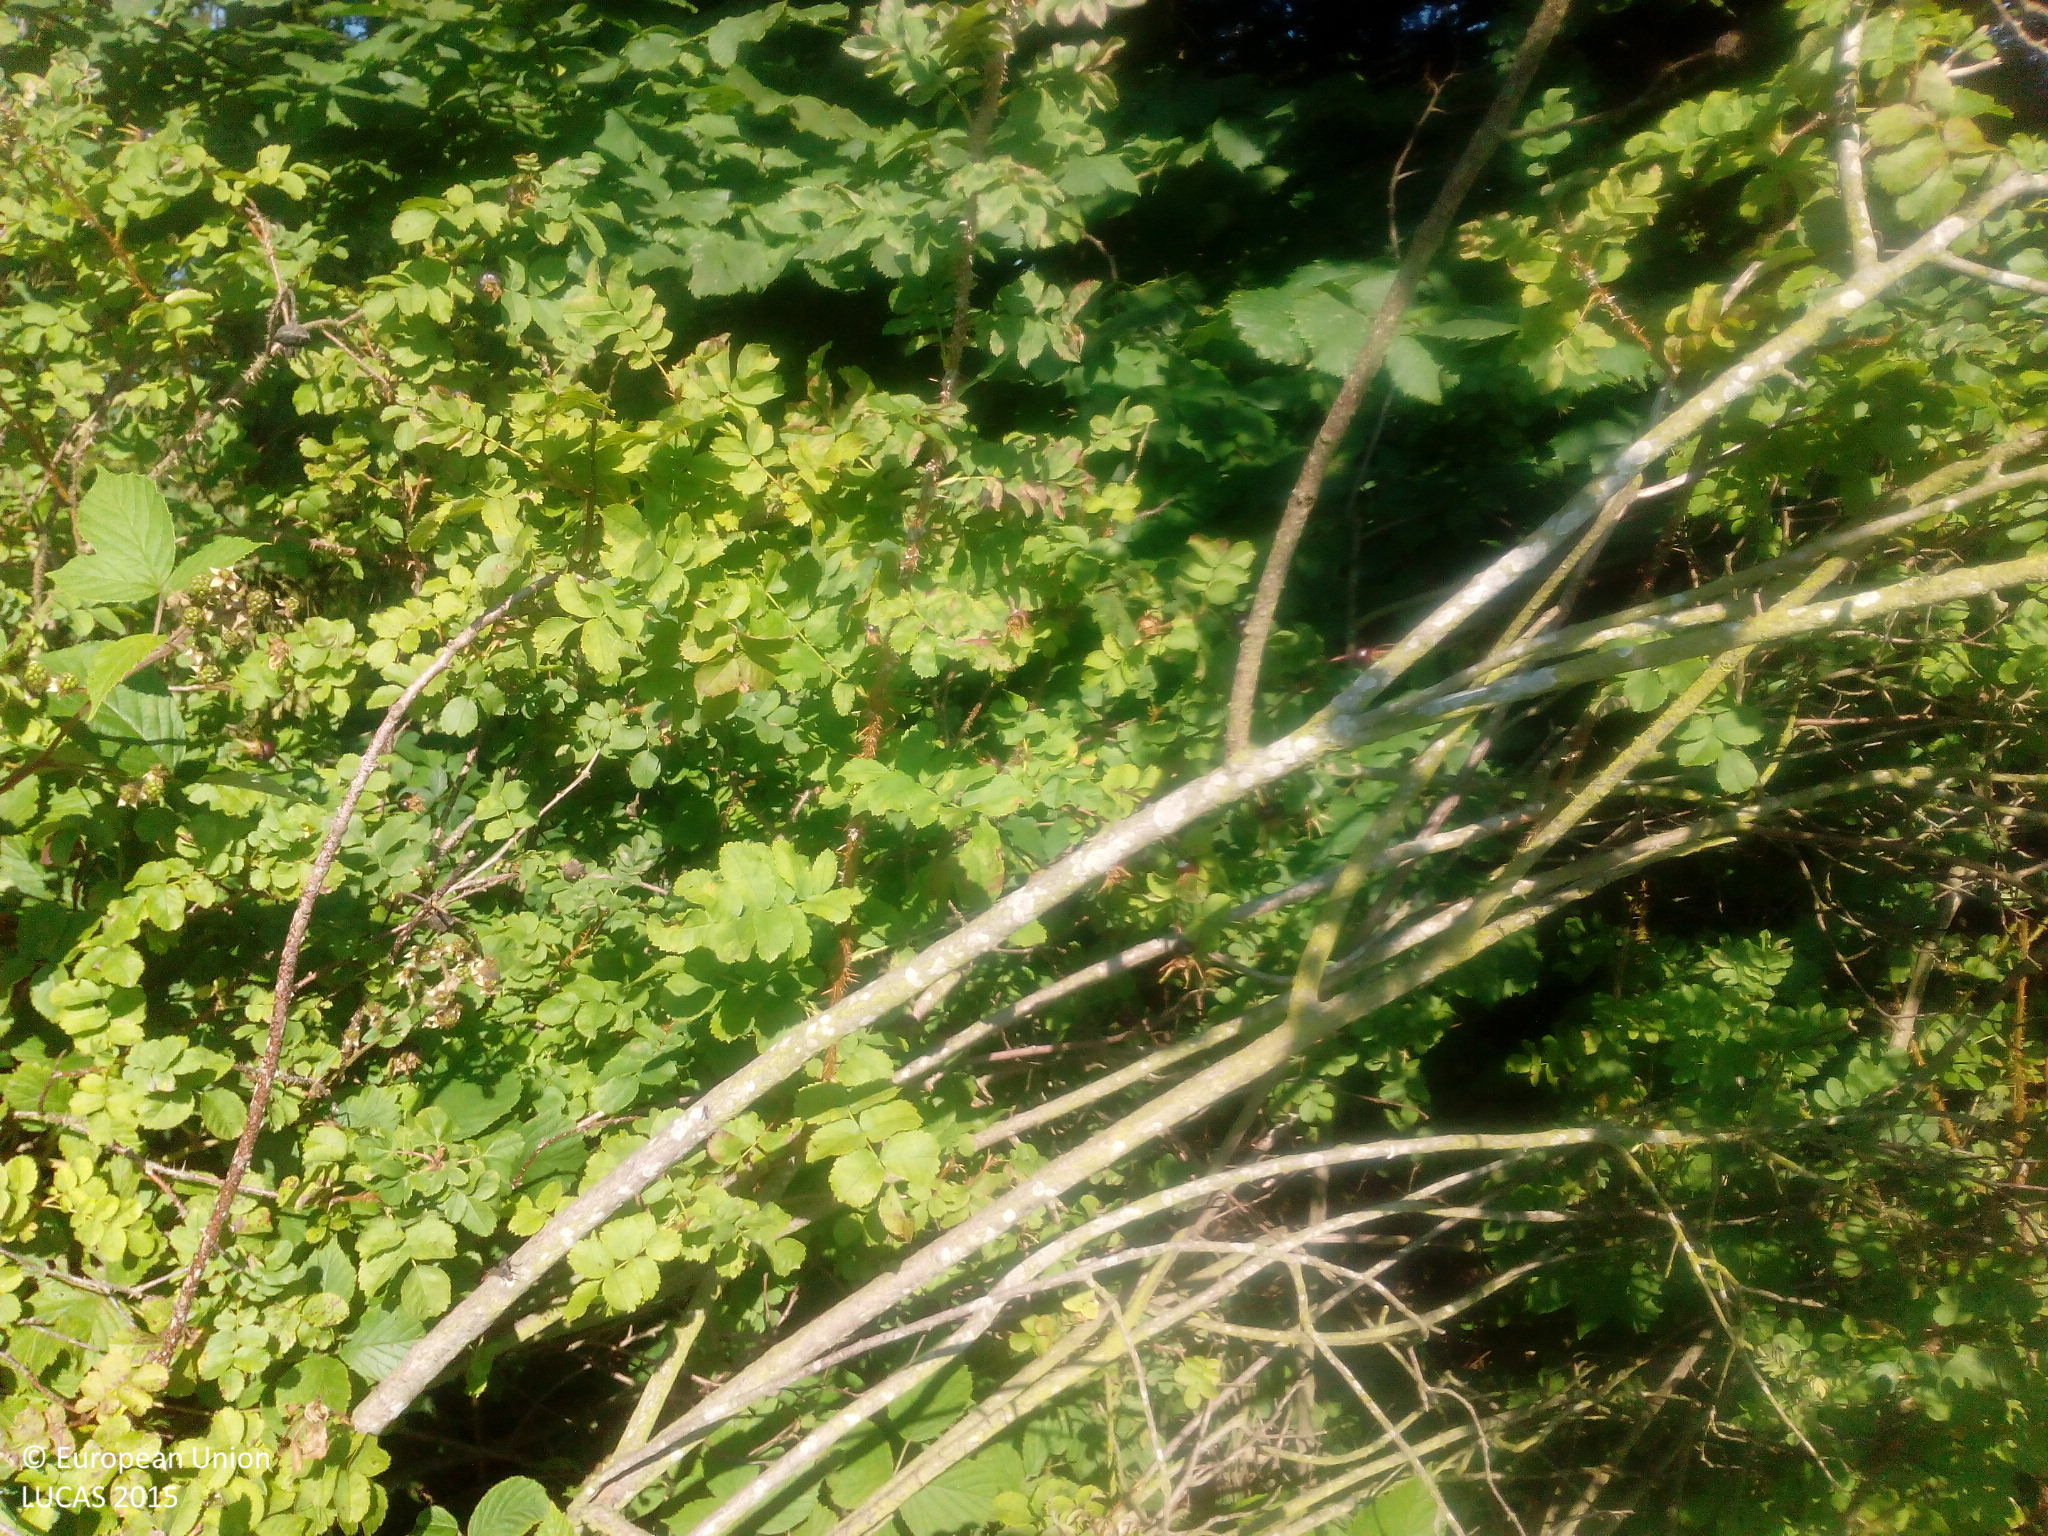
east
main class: Woodland
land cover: Spruce dominated mixed woodland
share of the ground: > 75 %
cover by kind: coniferous forest trees 60 %, broadleaved forest trees 40 %
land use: Semi-natural and natural areas not in use
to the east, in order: Spruce dominated mixed woodland; Spruce dominated coniferous woodland; Maize; Common wheat; Lines of trees; Fences; Grassland without tree/shrub cover; Fences; Spruce dominated coniferous woodland; Grassland without tree/shrub cover
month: August
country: DK
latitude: 55.6547
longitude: 11.7308
